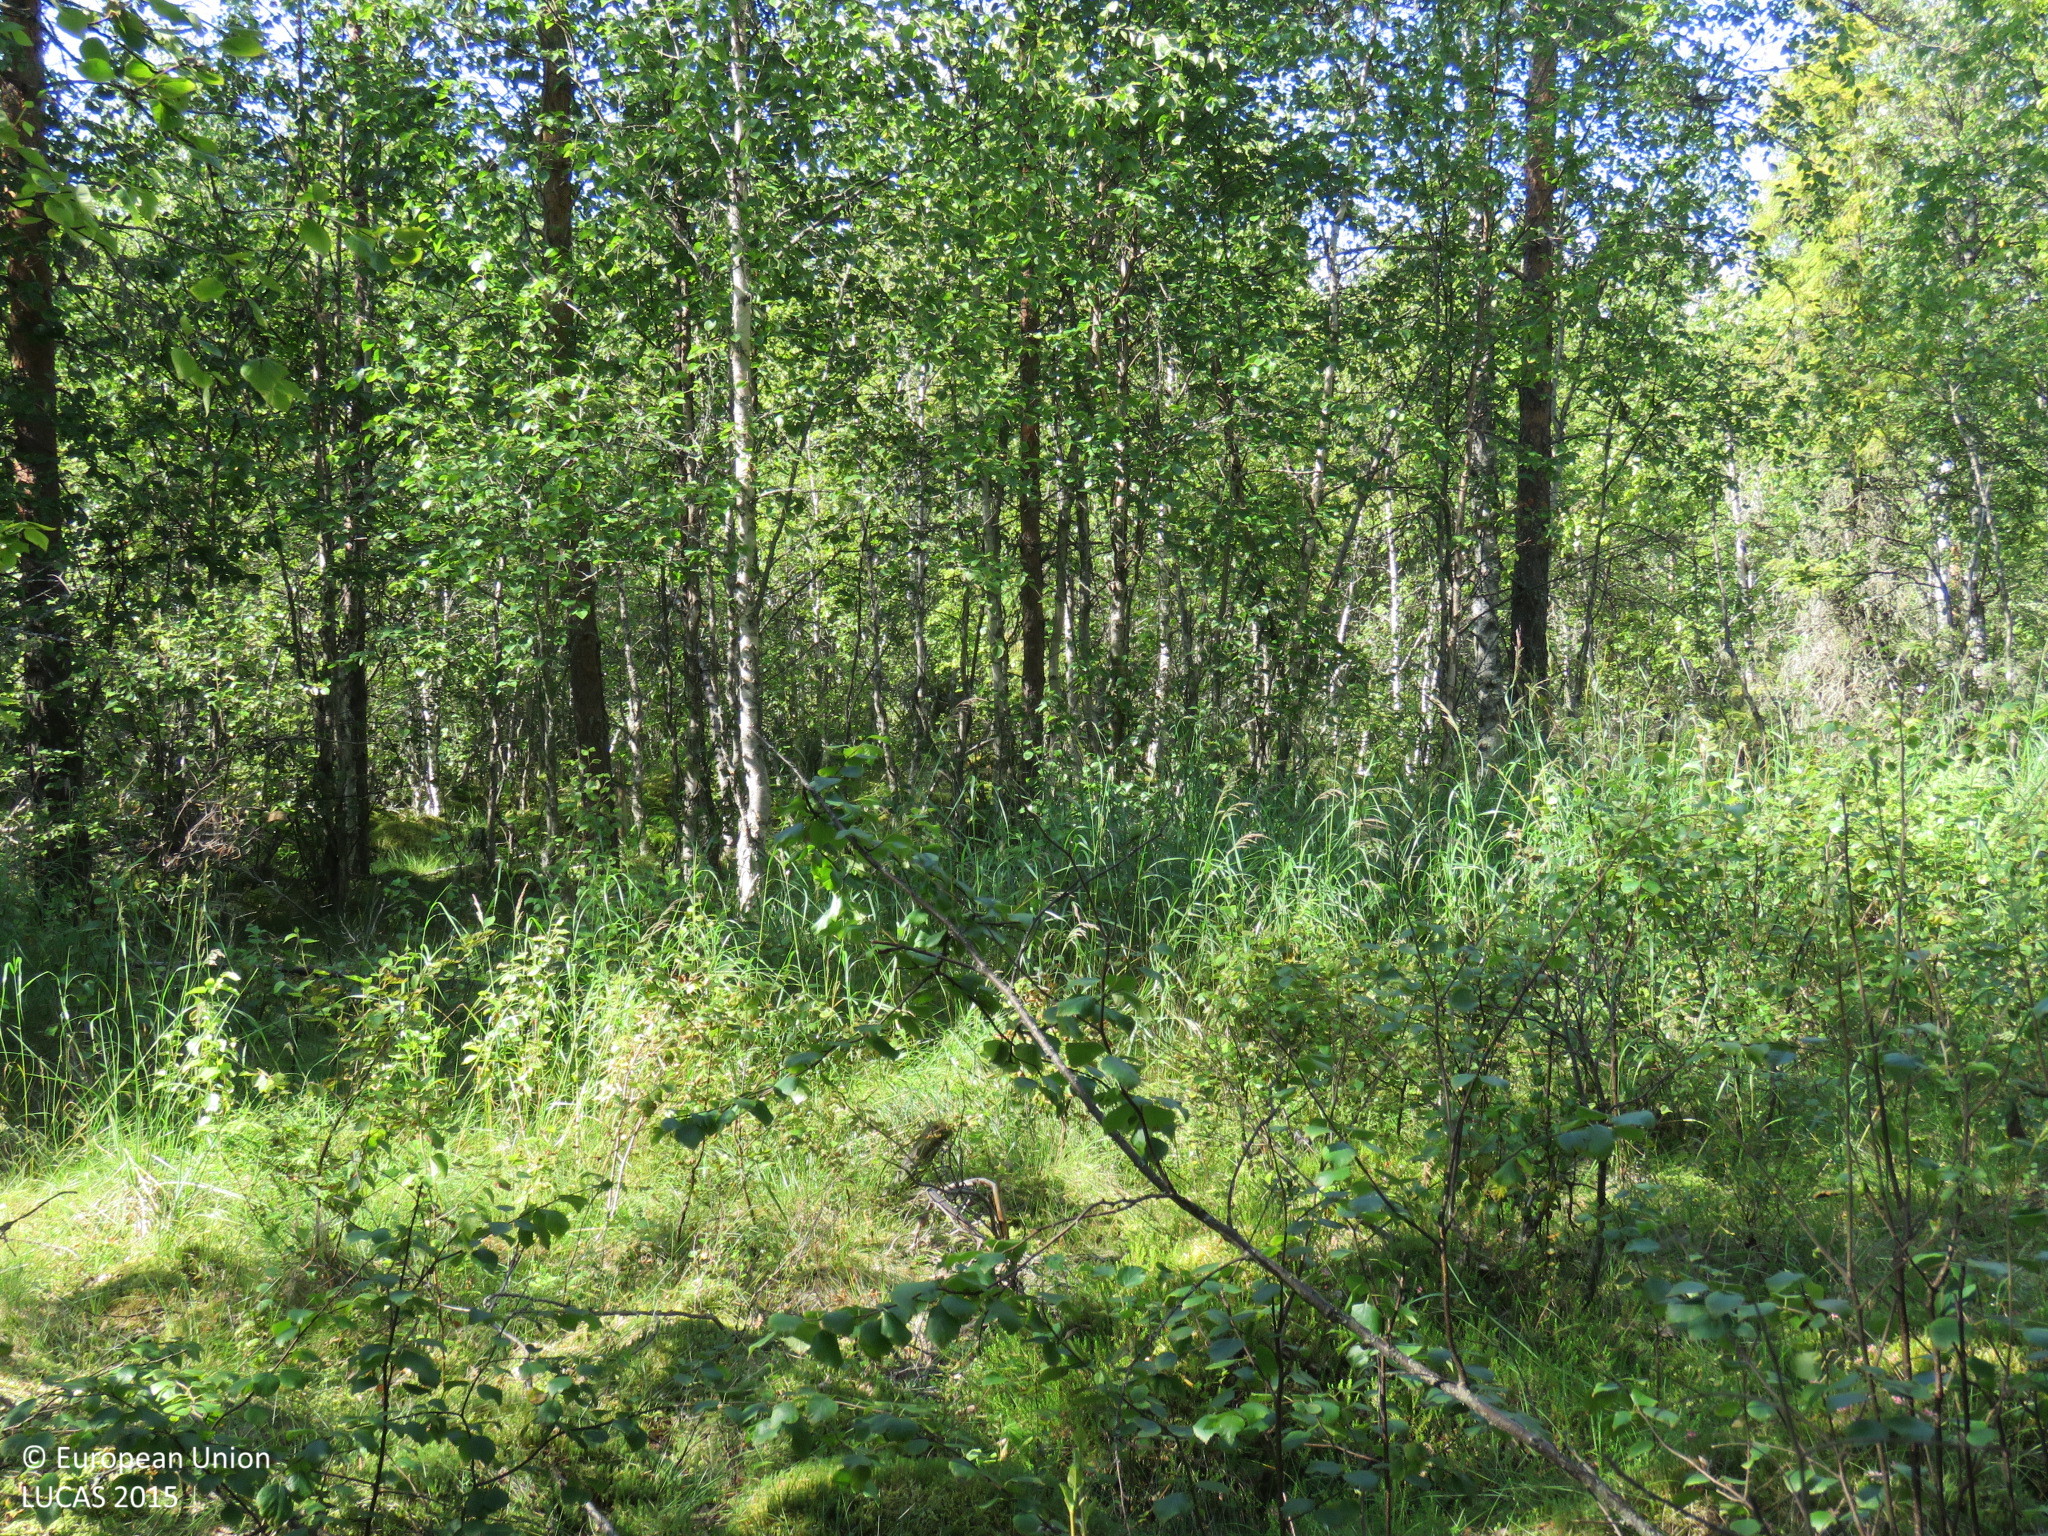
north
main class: Woodland
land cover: Pine dominated mixed woodland
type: mire and swamp forests
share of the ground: > 75 %
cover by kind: broadleaved forest trees 45 %, coniferous forest trees 35 %, herbaceous plants 10 %, shrubs 5 %, lichens and mosses 5 %
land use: Forestry
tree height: > 5 m
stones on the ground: < 10 %
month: July
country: FI
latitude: 64.7243
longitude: 26.2039
